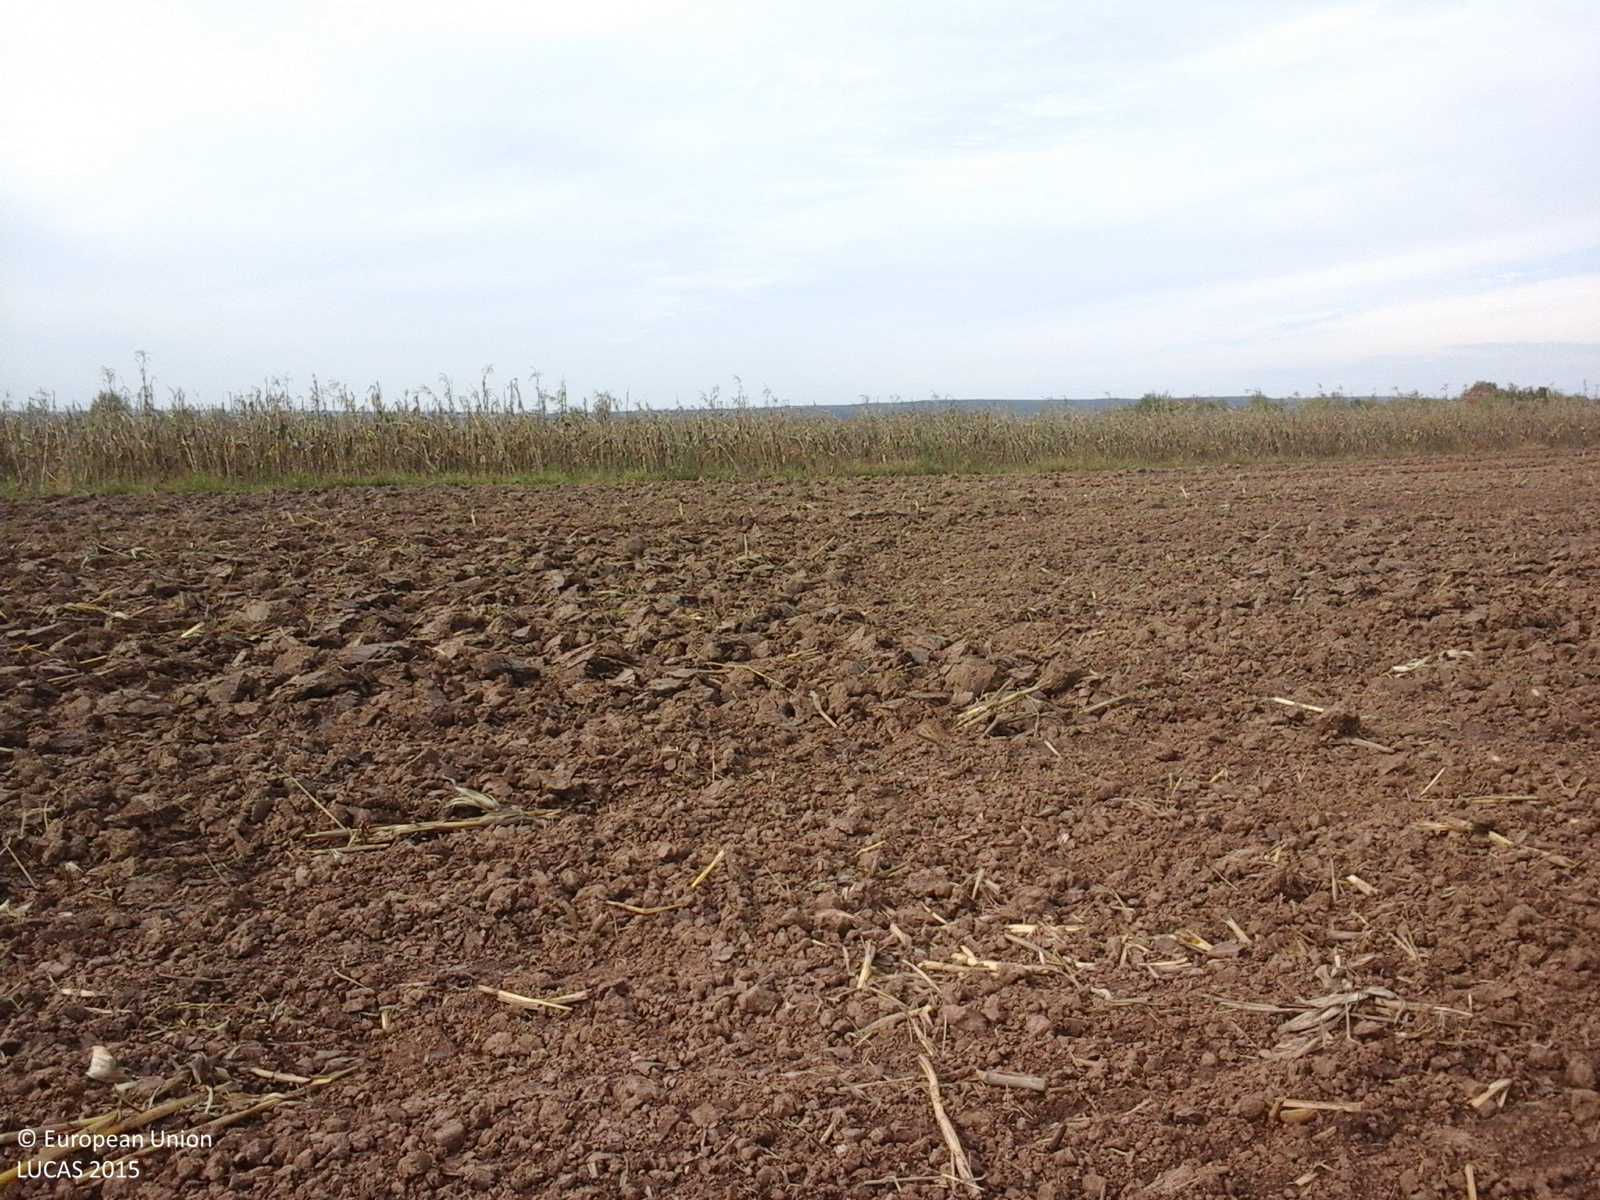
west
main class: Cropland
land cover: Maize
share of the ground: < 10 %
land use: Agriculture (excluding fallow land and kitchen gardens)
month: October
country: RO
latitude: 44.9998
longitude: 26.0556
